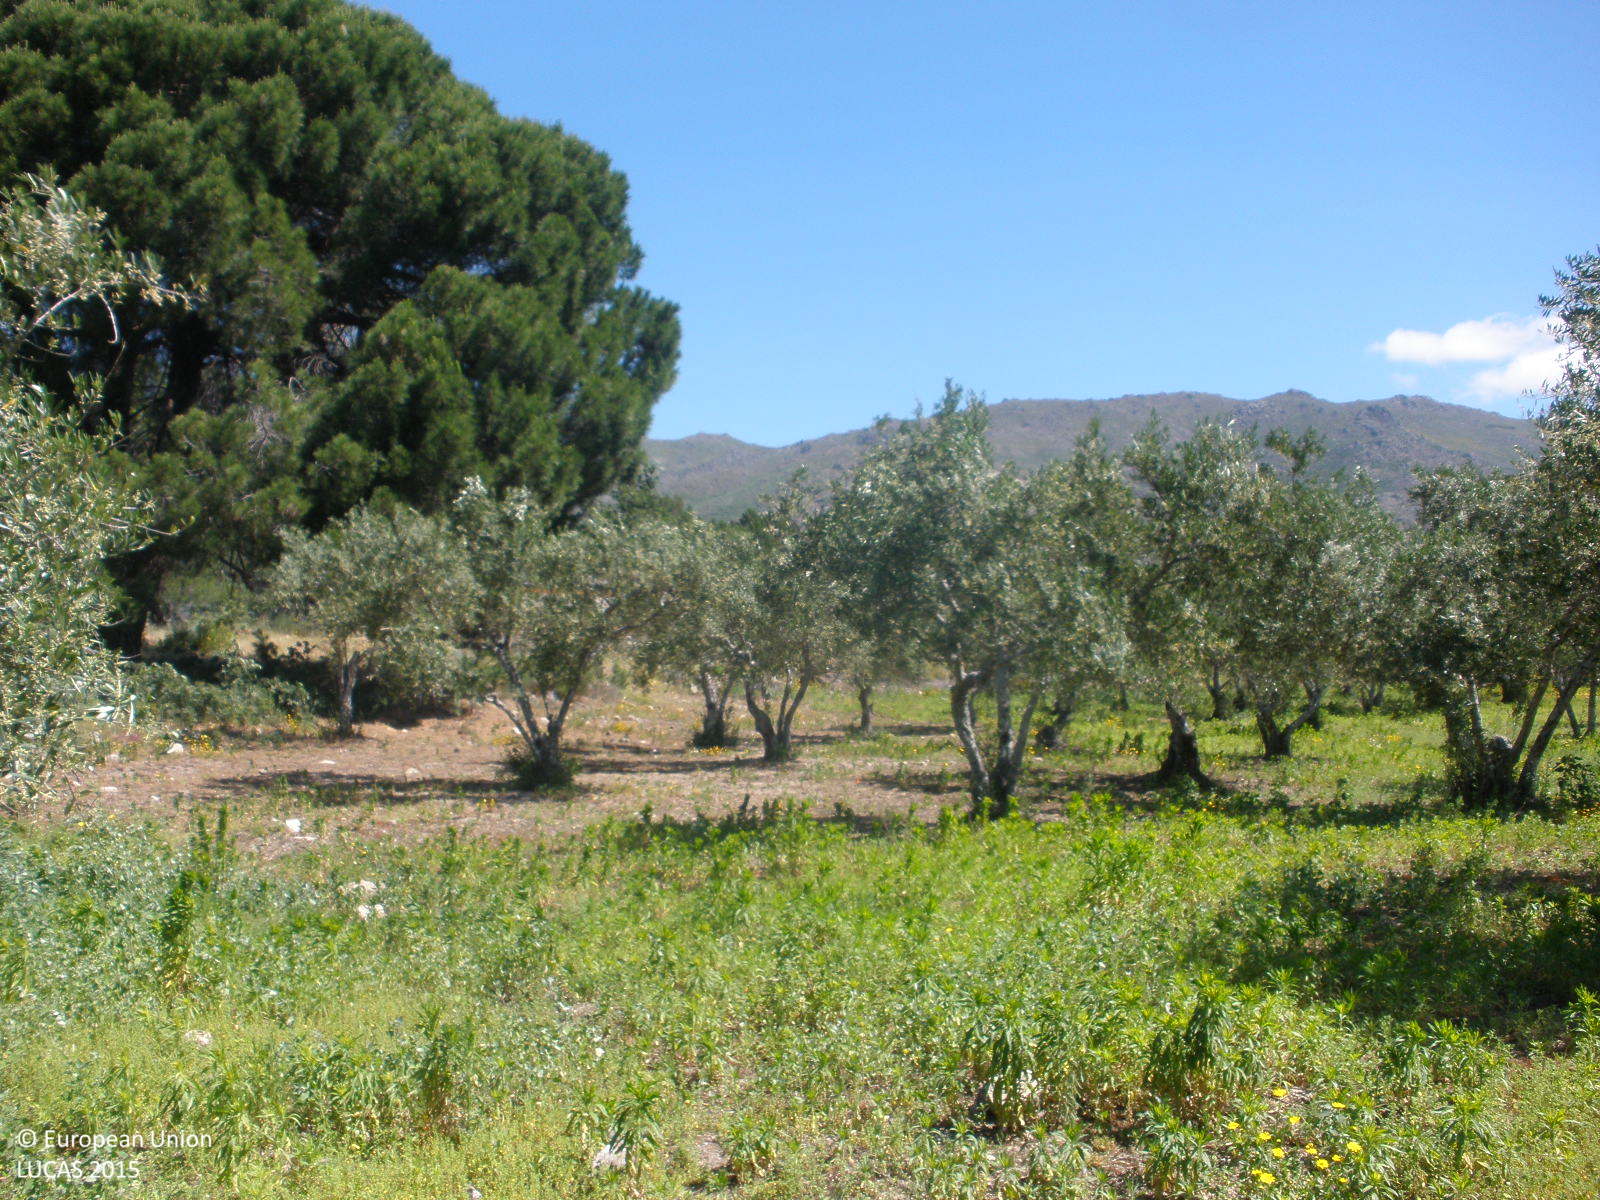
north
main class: Cropland
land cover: Olive groves
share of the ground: 50 - 75 %
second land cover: Spontaneously vegetated surfaces
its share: > 75 %
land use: Agriculture (excluding fallow land and kitchen gardens)
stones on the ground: < 10 %
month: May
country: ES
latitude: 40.2159
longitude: -6.8586
